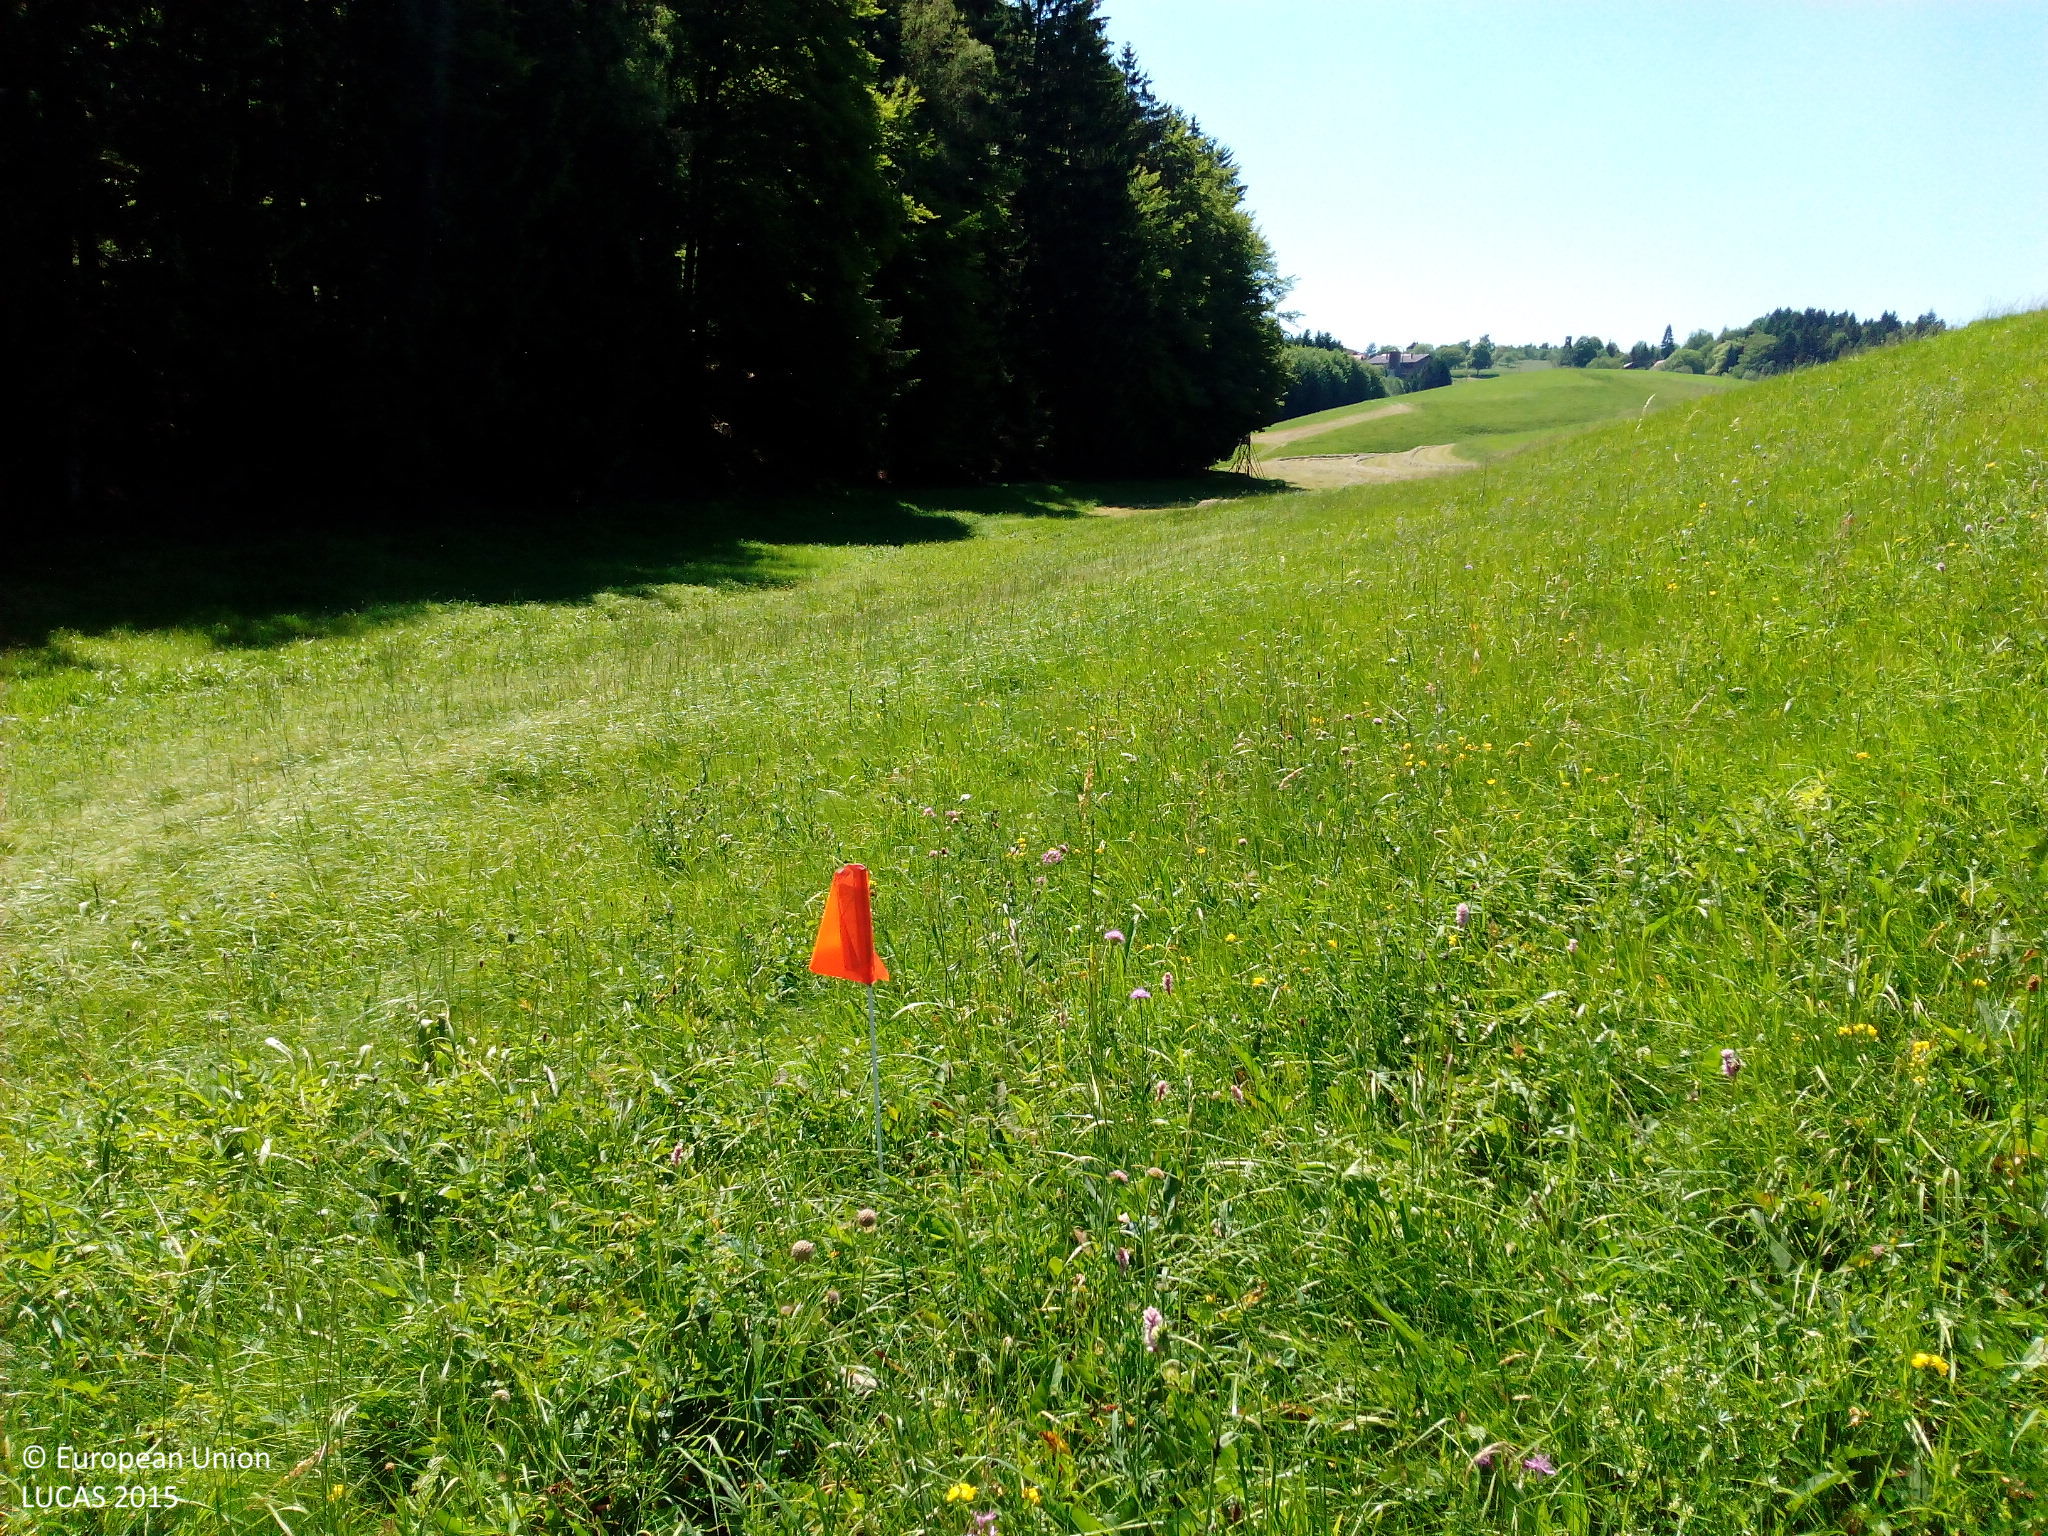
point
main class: Grassland
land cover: Grassland without tree/shrub cover
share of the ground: > 75 %
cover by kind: herbaceous plants 100 %
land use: Agriculture (excluding fallow land and kitchen gardens)
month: June
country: DE
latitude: 48.9248
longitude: 9.6862
